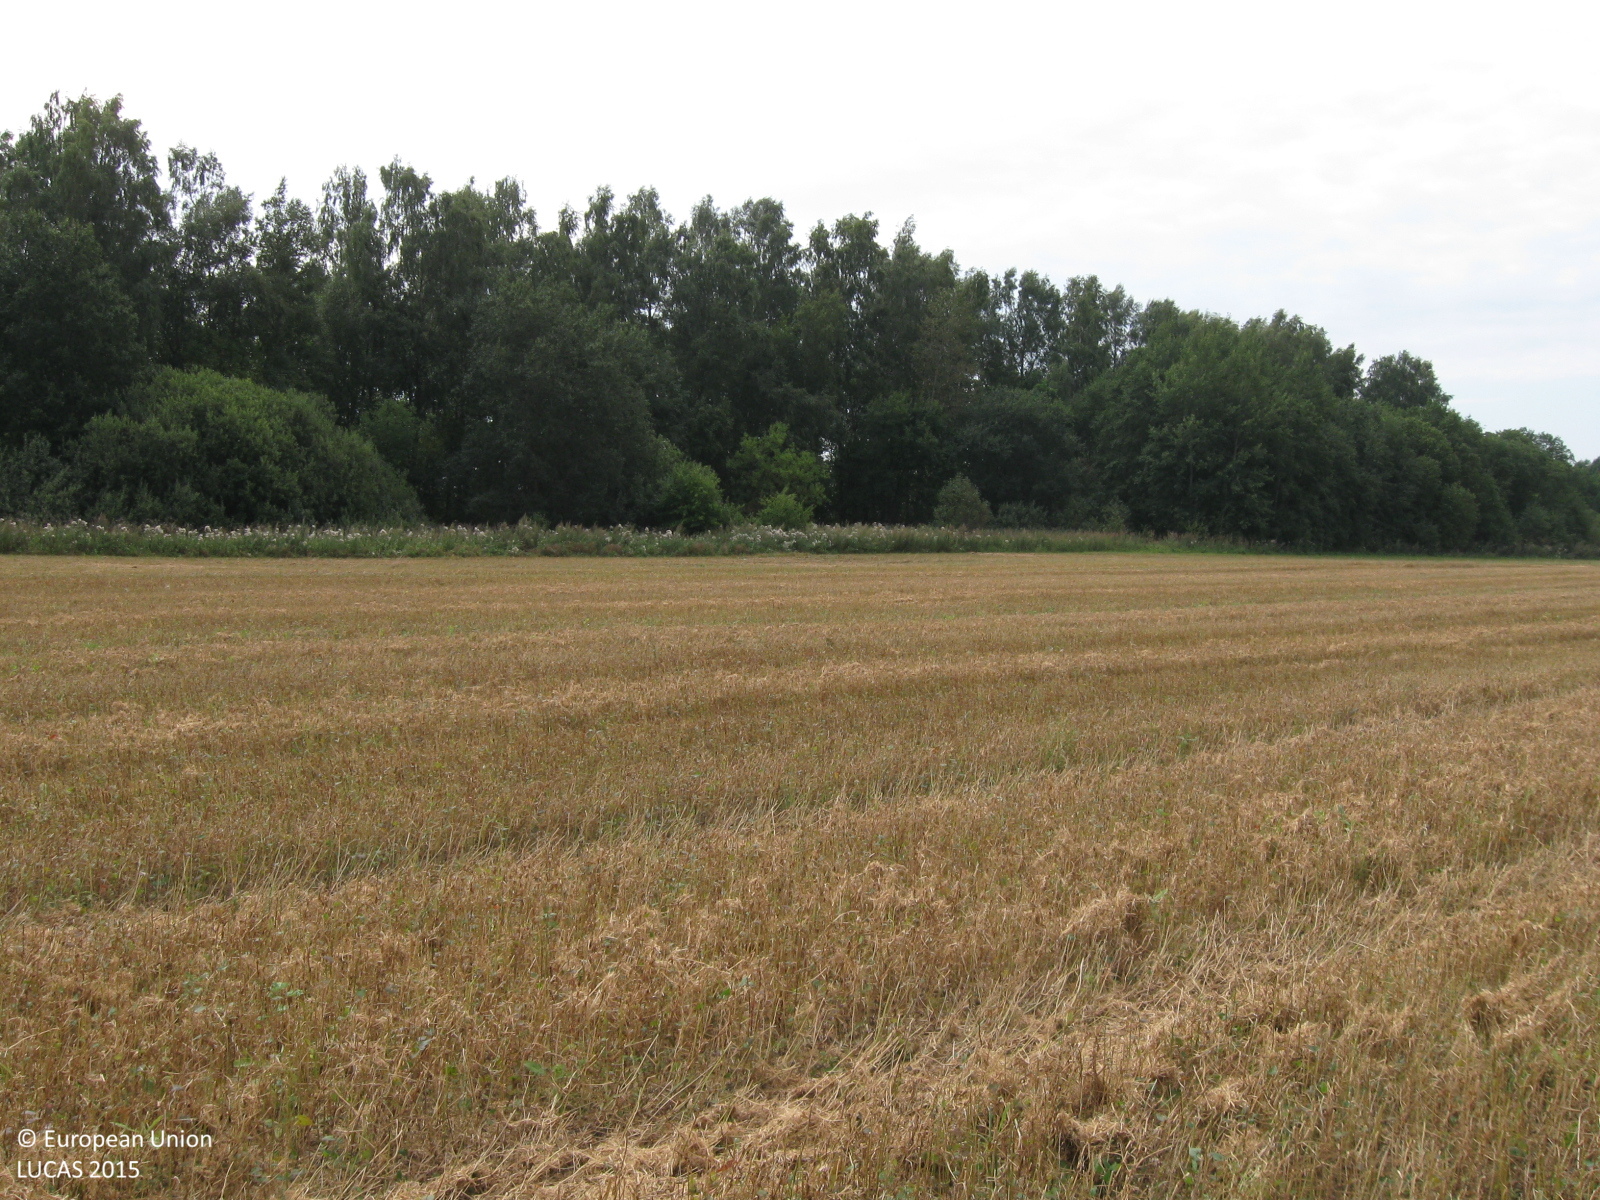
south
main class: Cropland
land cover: Dry pulses
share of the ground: > 75 %
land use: Agriculture (excluding fallow land and kitchen gardens)
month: August
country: LT
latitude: 55.4688
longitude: 22.9931
